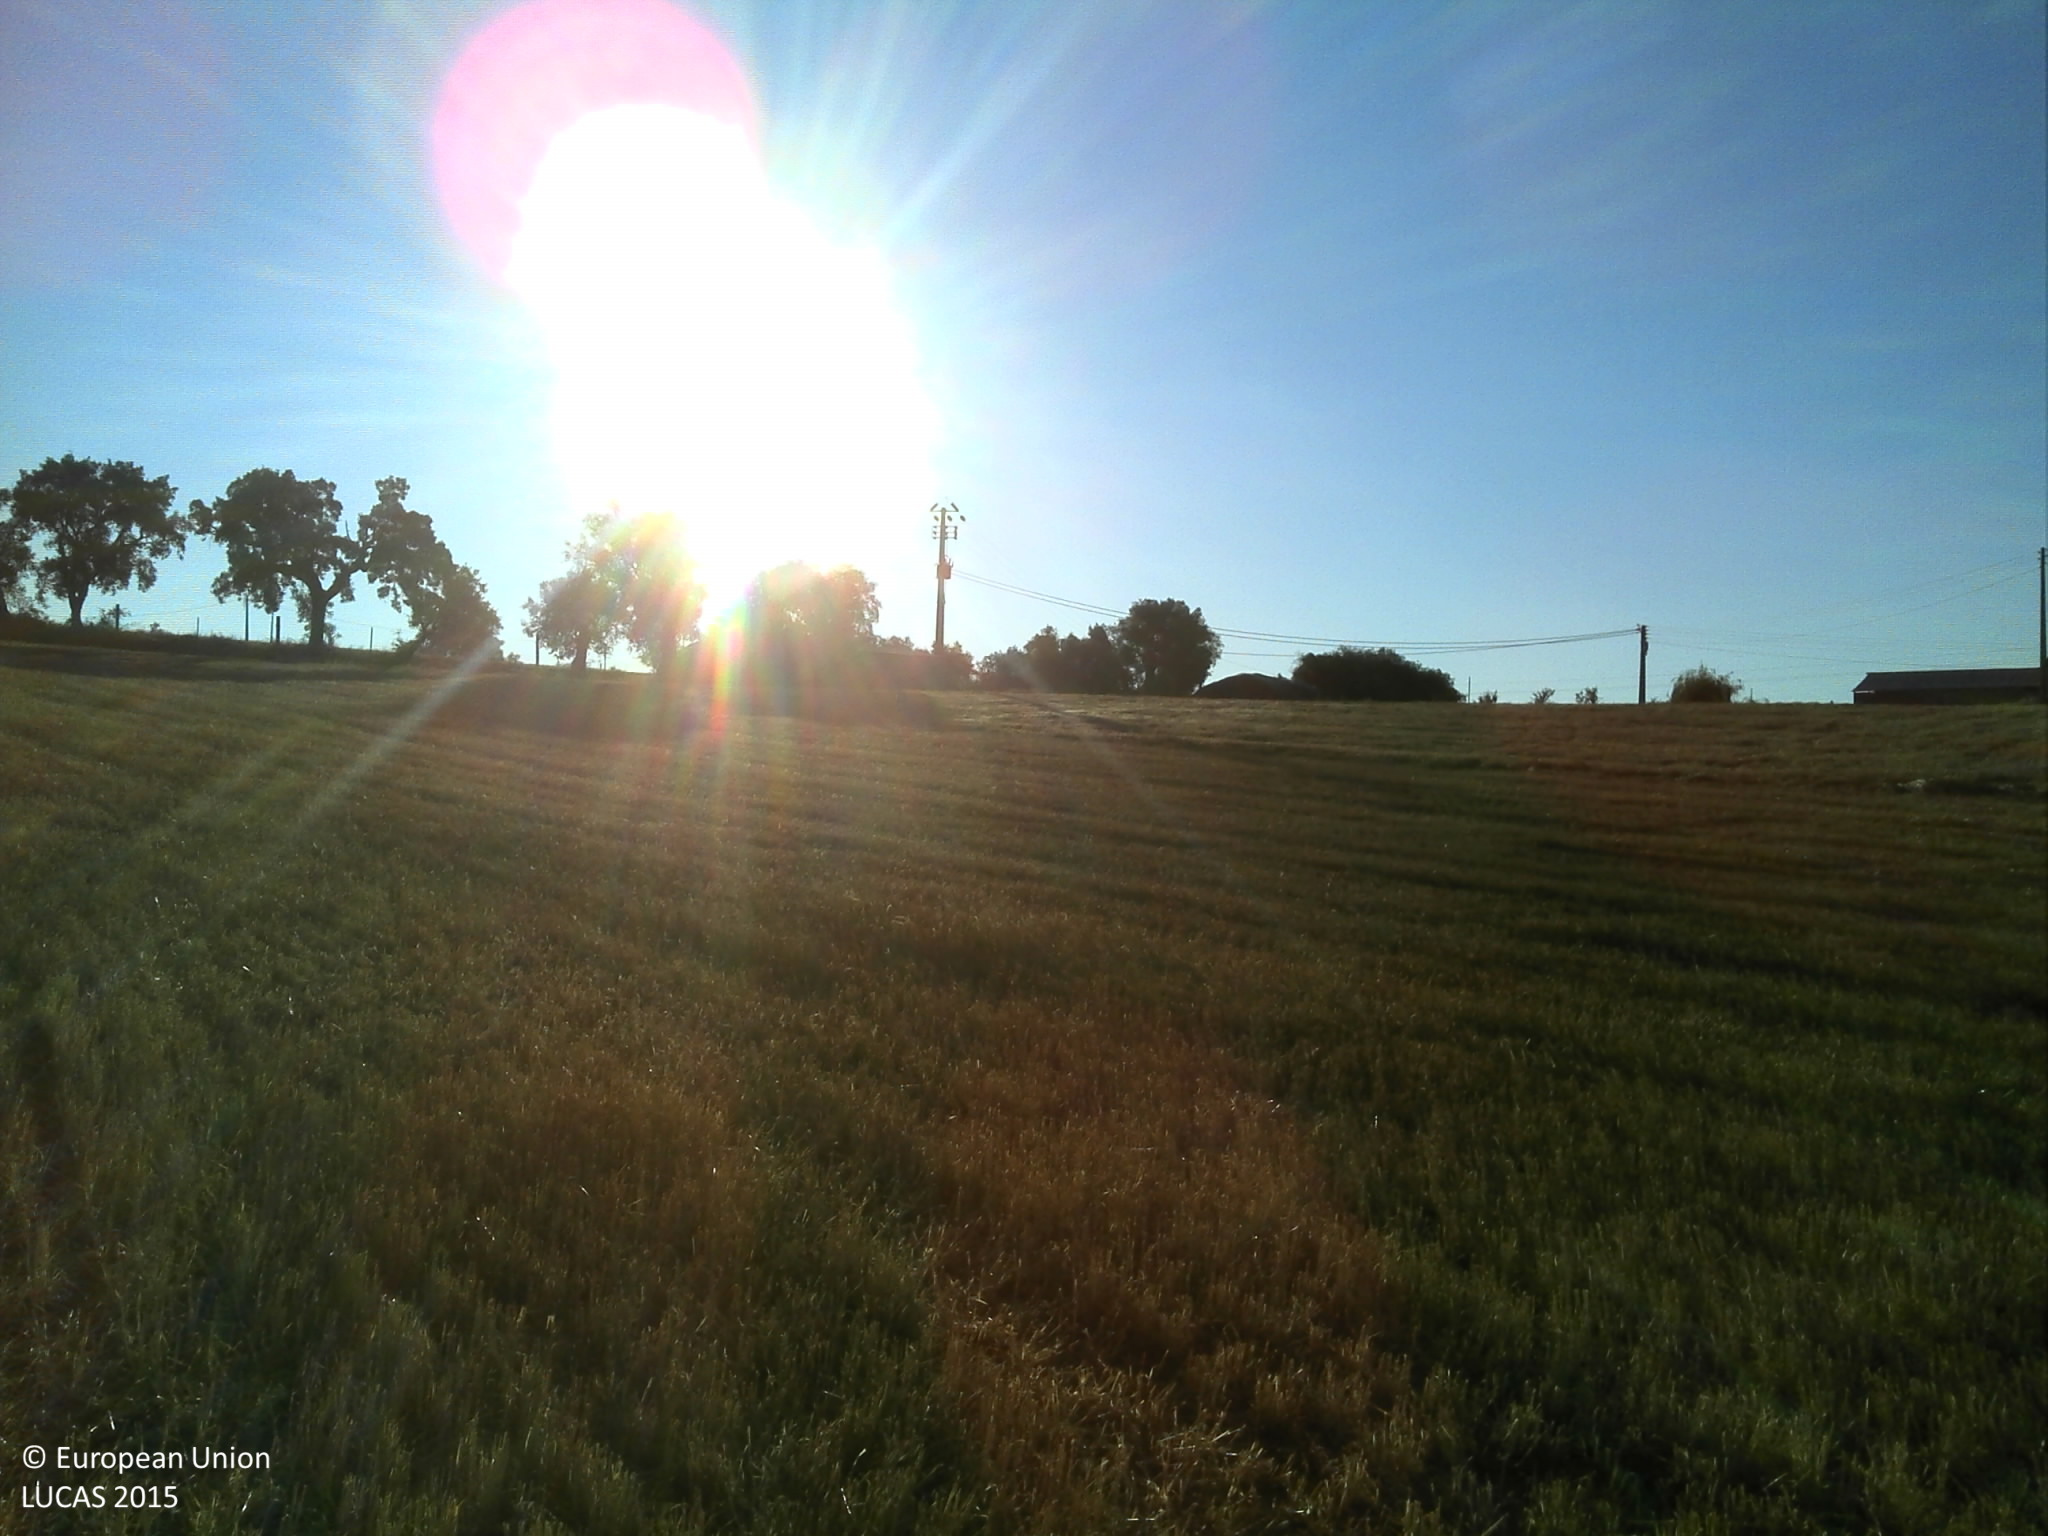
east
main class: Cropland
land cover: Triticale
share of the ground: < 10 %
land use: Agriculture (excluding fallow land and kitchen gardens)
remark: Harvested field
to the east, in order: Triticale; Oats; Electric lines; Oats; Artificial constructions in urban areas; Broadleaved woodland; Fences; Electric lines; Grass margins; Tracks; Grass margins; Olive groves; Dry stone walls; Tracks; Electric lines; Dry stone walls; Single bushes/trees; Fences; Other bare soil; Broadleaved woodland; Electric lines; Broadleaved woodland; Fences; Tracks; Electric lines; Fences; Grass margins
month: July
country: PT
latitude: 38.8712
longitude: -7.5678
